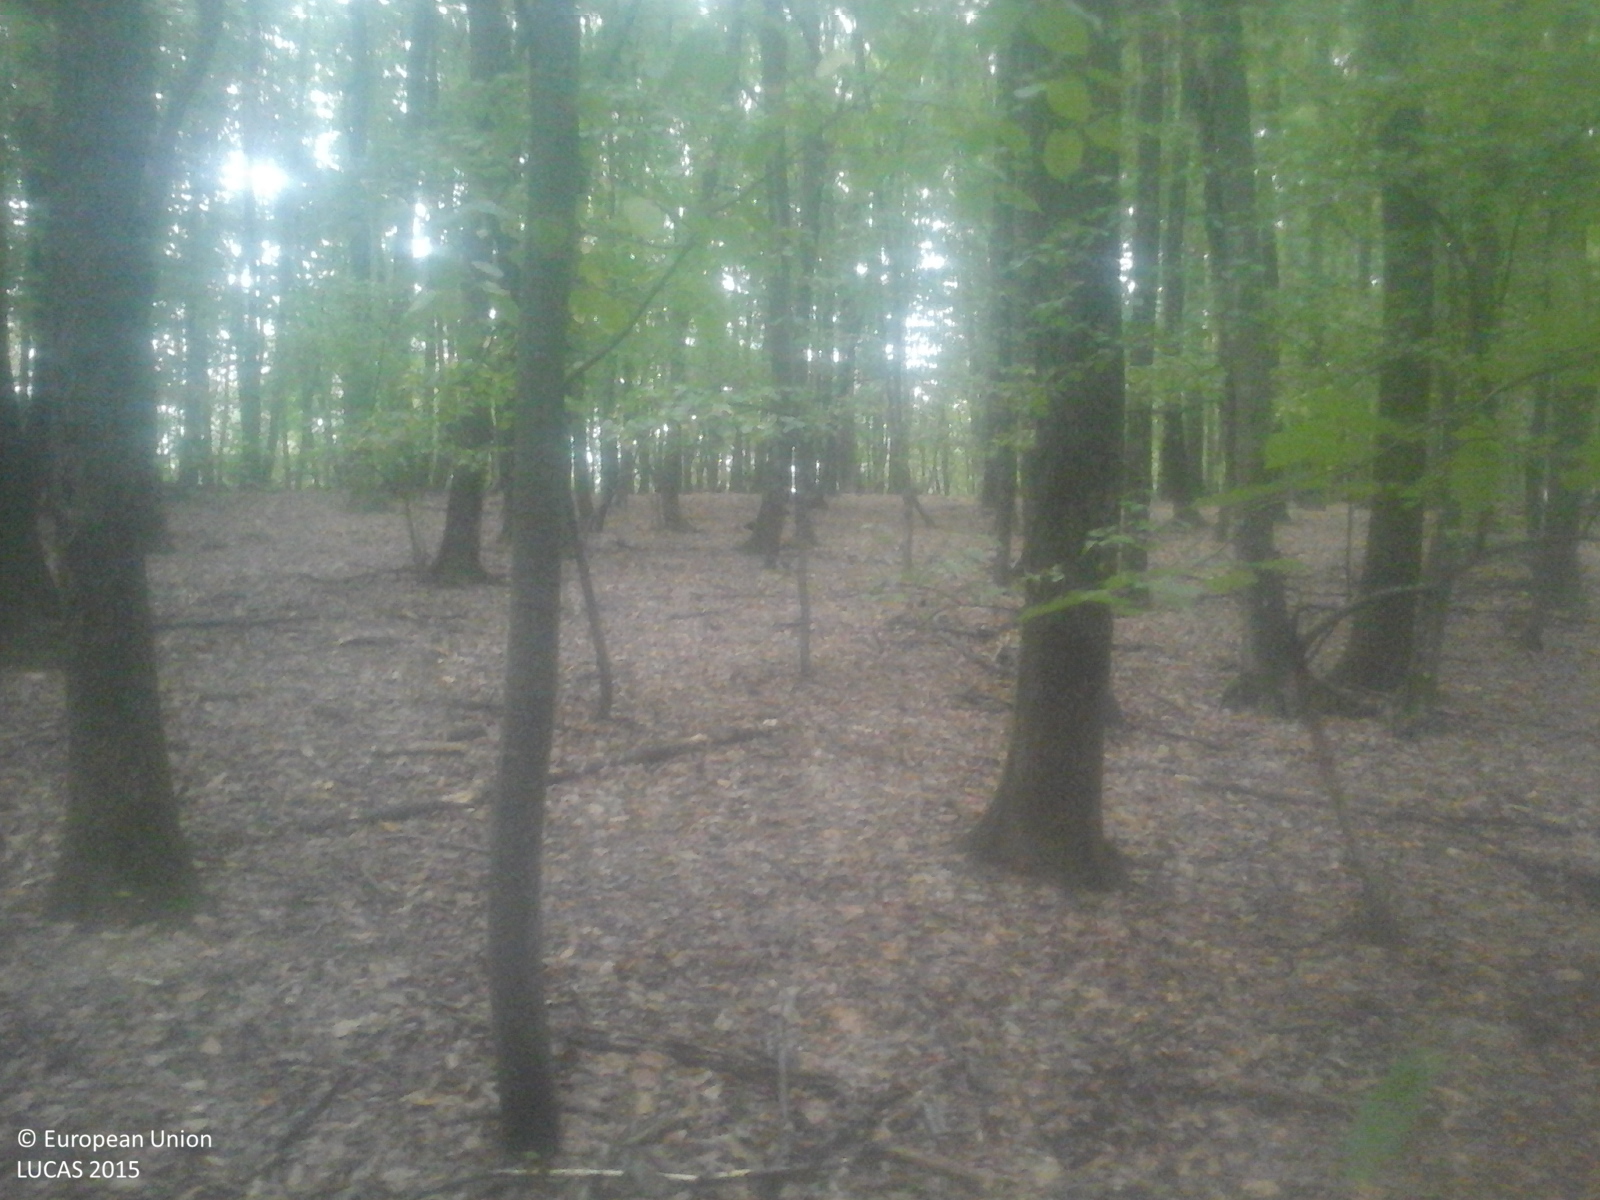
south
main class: Woodland
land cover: Broadleaved woodland
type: beech forest
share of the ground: > 75 %
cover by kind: broadleaved forest trees 100 %
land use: Forestry
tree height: > 5 m
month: September
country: RO
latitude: 45.5113
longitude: 21.9809
